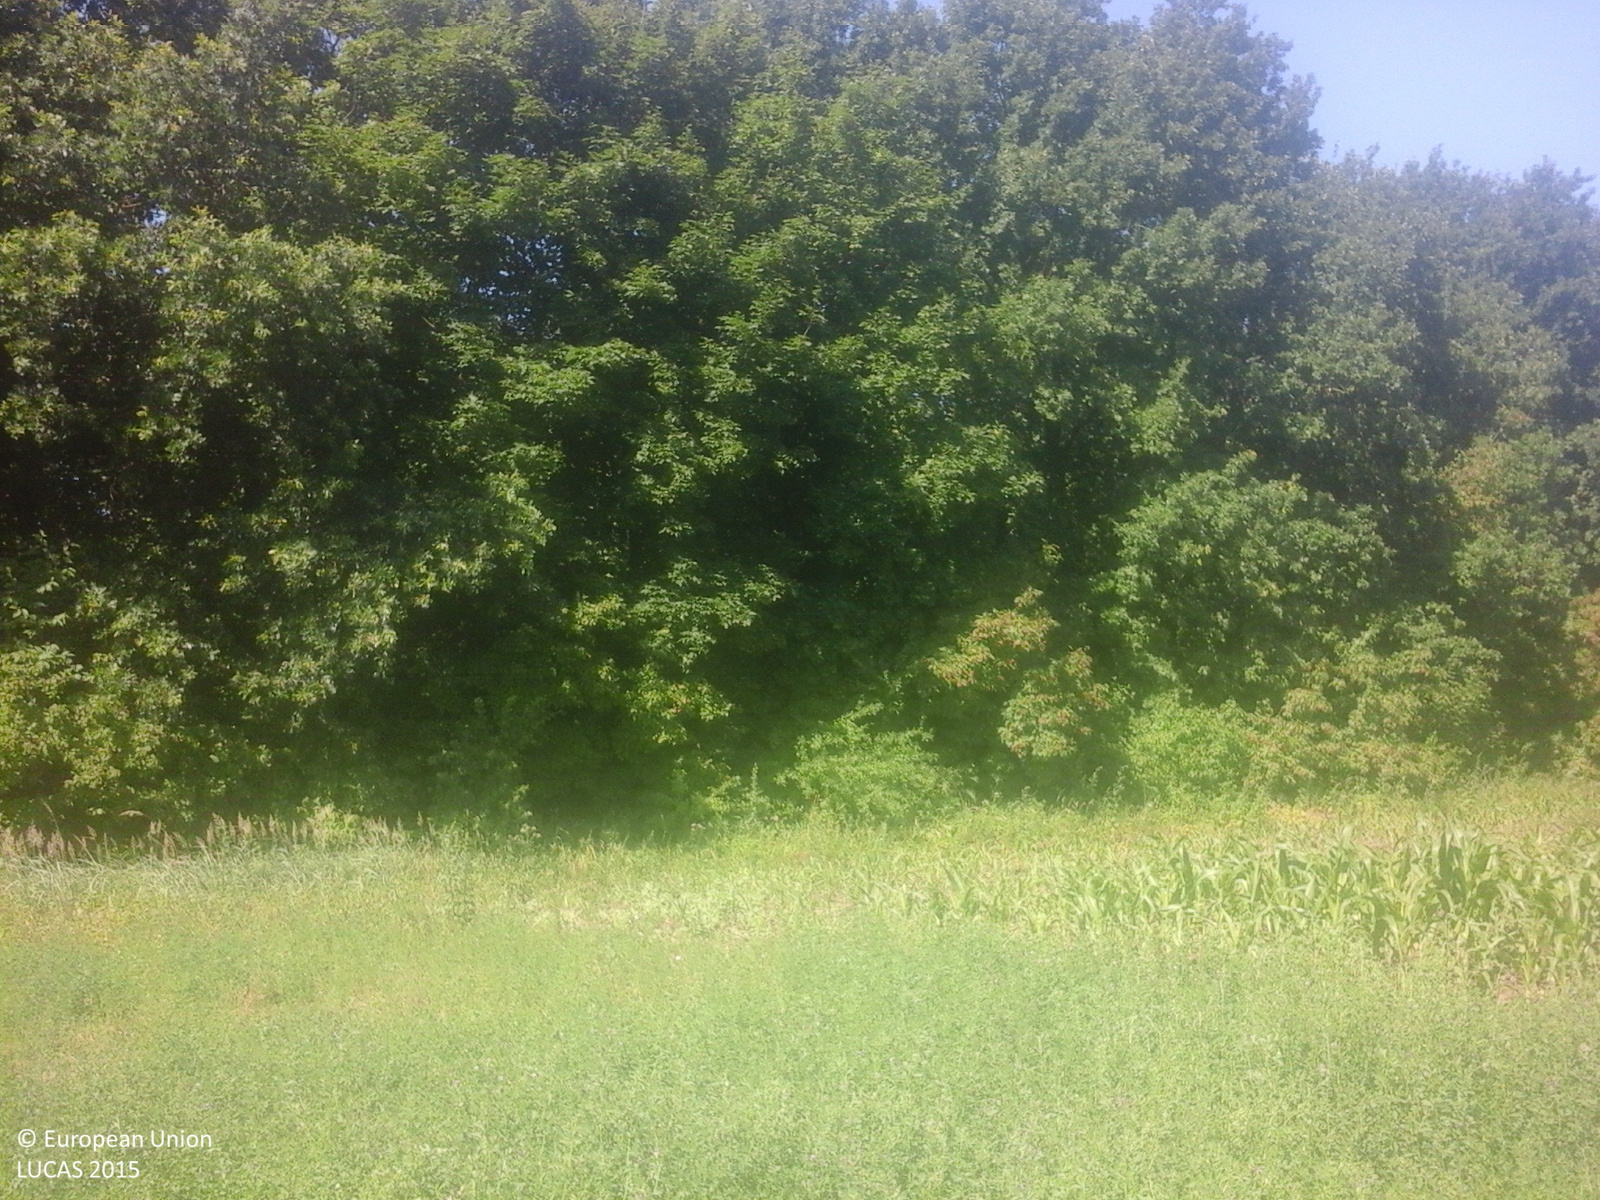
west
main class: Cropland
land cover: Lucerne
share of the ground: > 75 %
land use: Agriculture (excluding fallow land and kitchen gardens)
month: June
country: RO
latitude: 47.8282
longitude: 27.1140
